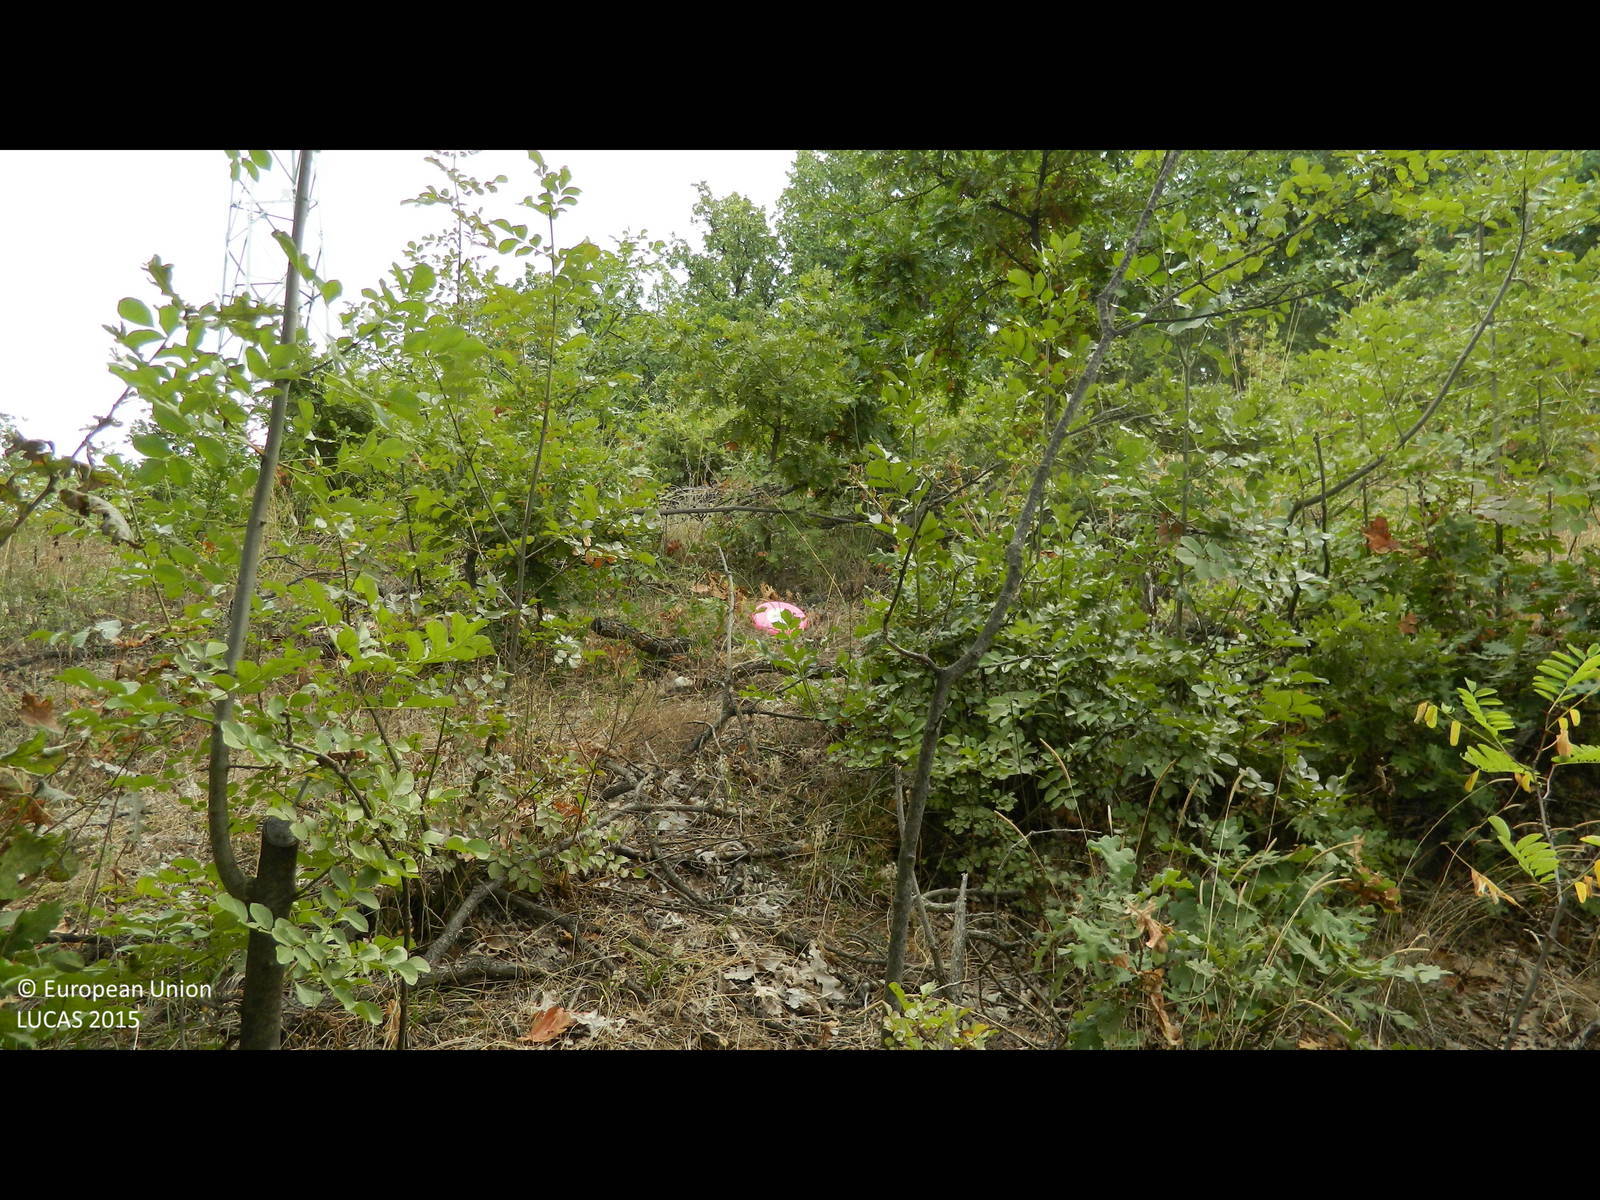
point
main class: Woodland
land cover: Broadleaved woodland
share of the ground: > 75 %
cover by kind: broadleaved forest trees 90 %, herbaceous plants 10 %
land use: Forestry
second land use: Electricity, gas and thermal power distribution
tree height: < 5 m
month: September
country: BG
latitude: 41.7913
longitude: 25.7952
